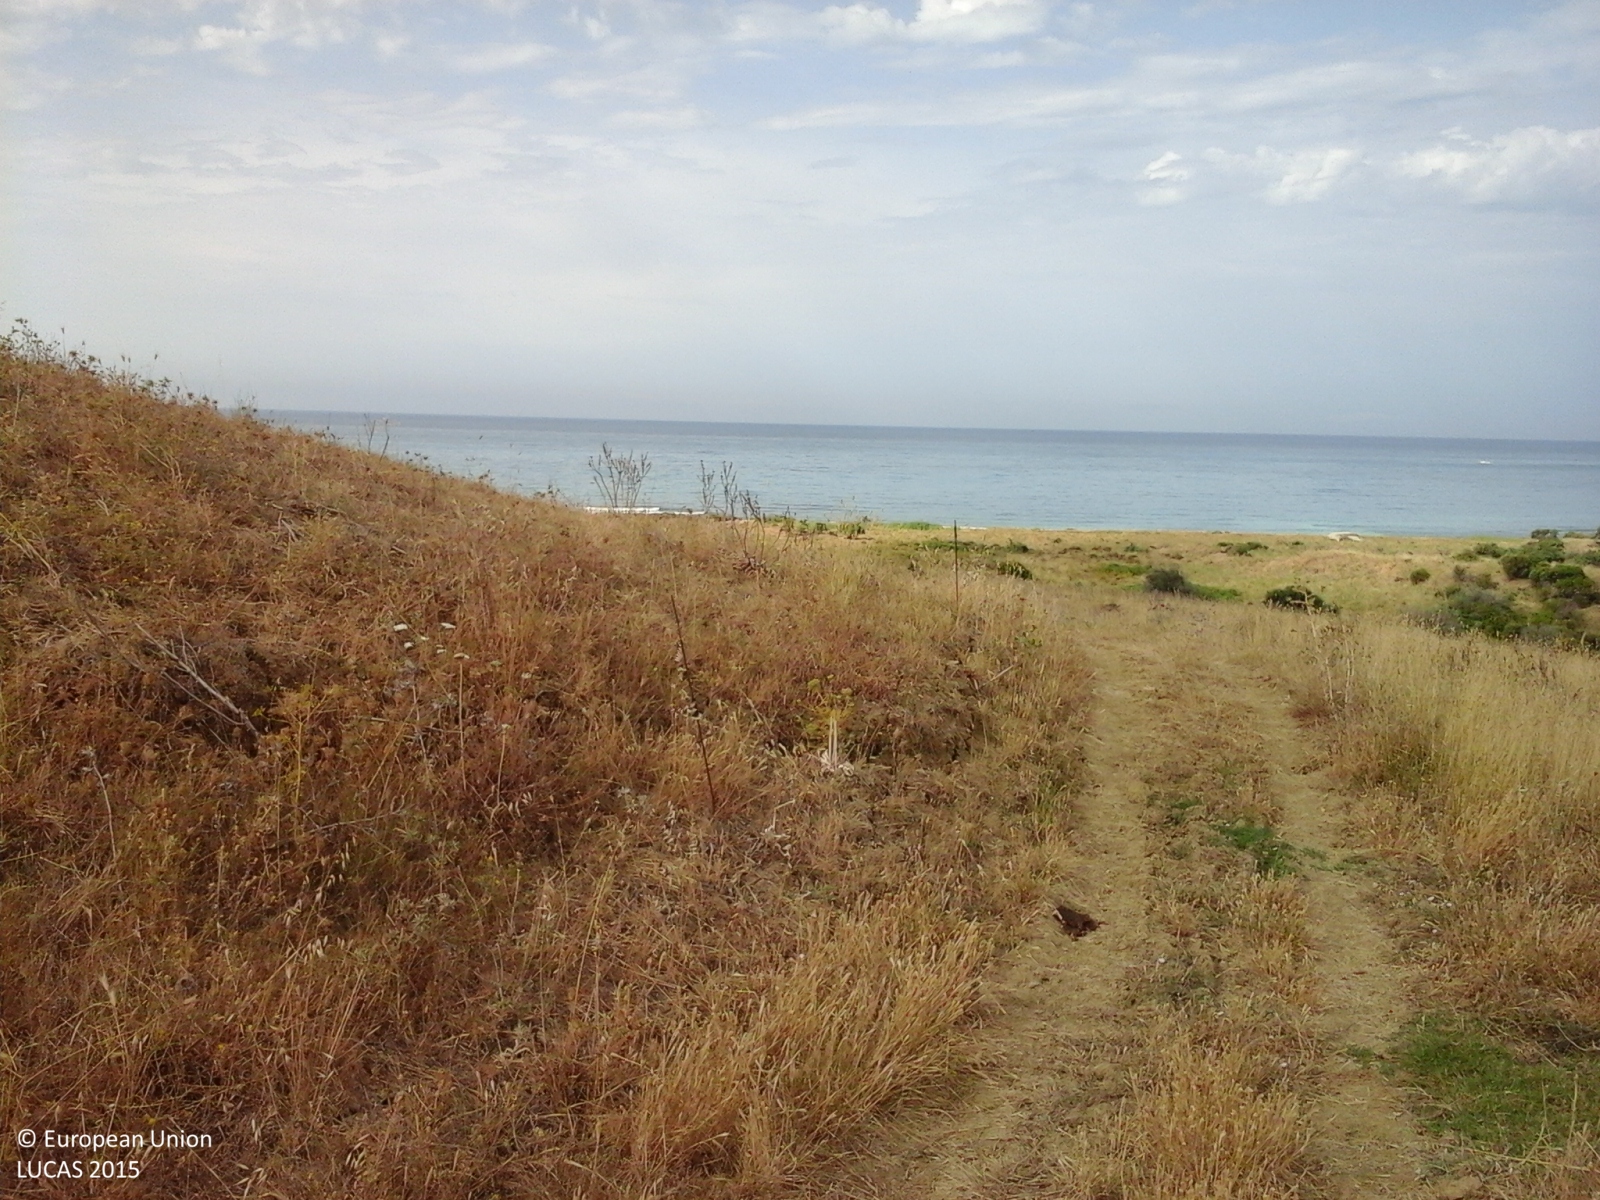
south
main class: Grassland
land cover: Grassland without tree/shrub cover
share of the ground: > 75 %
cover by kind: herbaceous plants 100 %
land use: Agriculture (excluding fallow land and kitchen gardens)
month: June
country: IT
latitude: 37.4961
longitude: 13.1317
